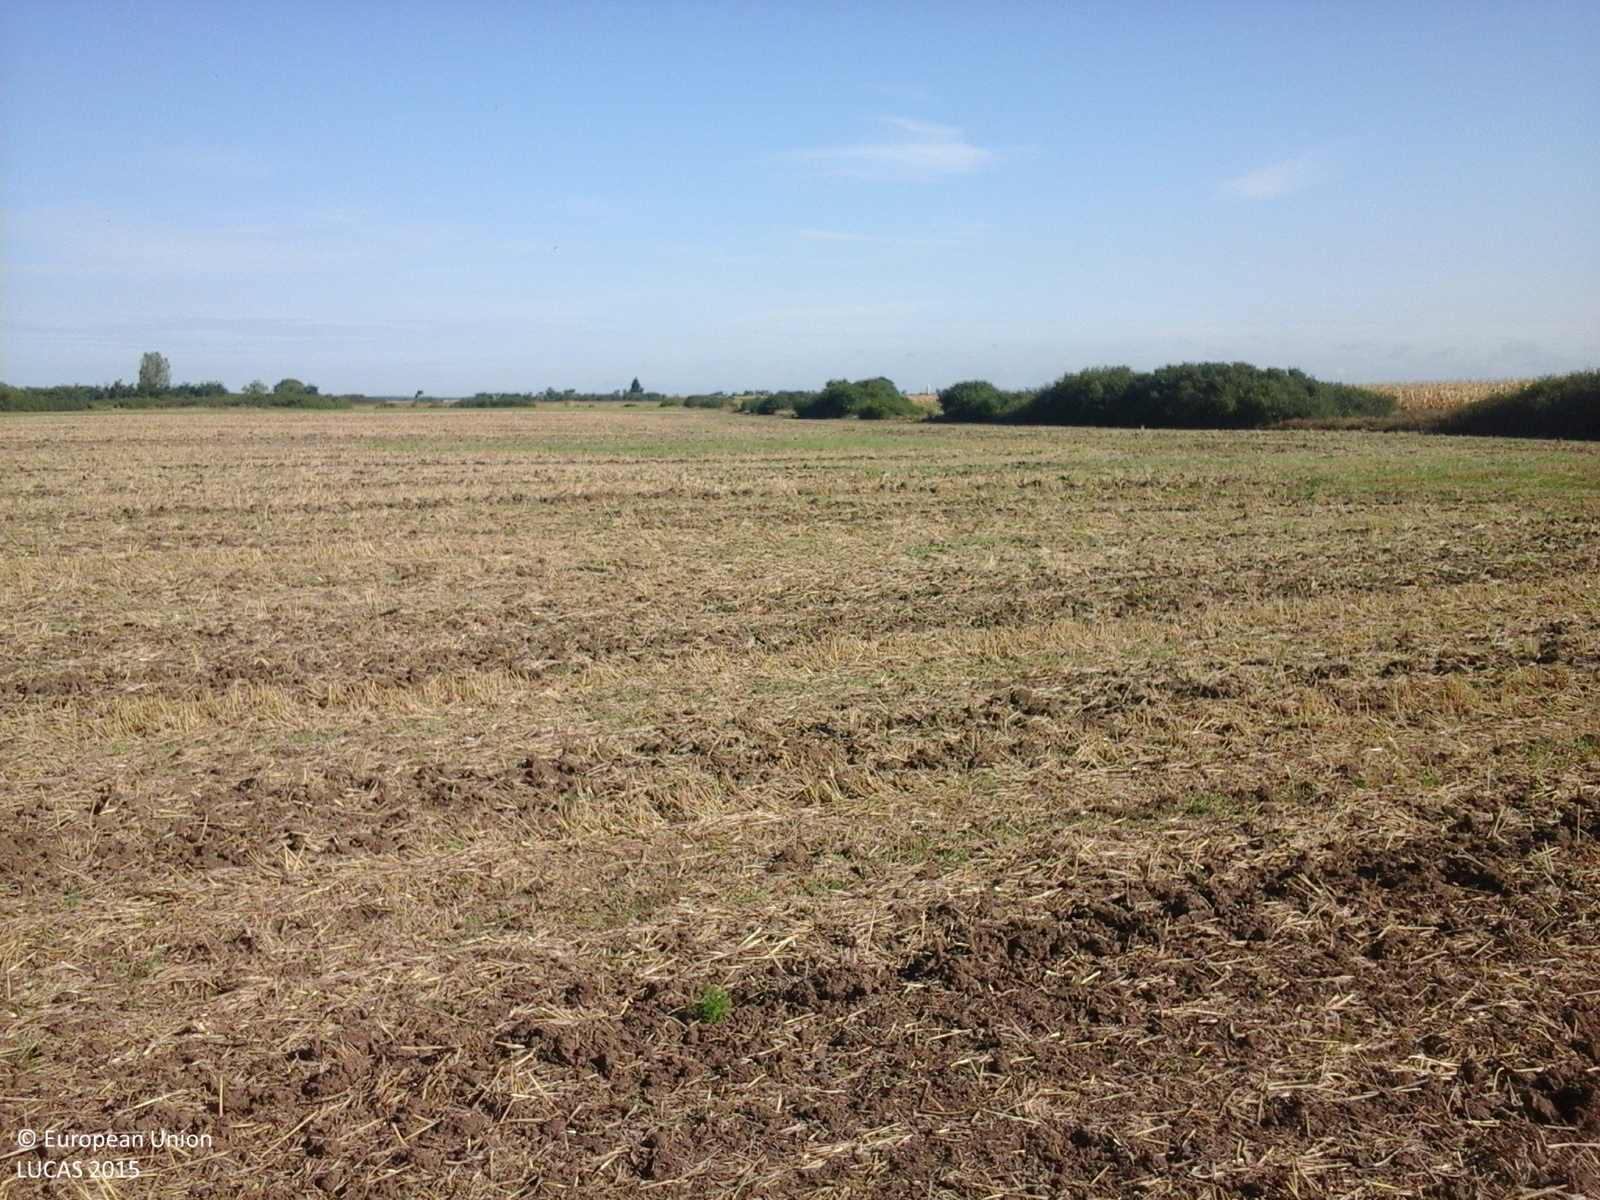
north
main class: Cropland
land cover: Common wheat
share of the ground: 25 - 50 %
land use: Agriculture (excluding fallow land and kitchen gardens)
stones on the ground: < 10 %
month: September
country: RO
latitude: 47.5669
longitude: 22.7823
